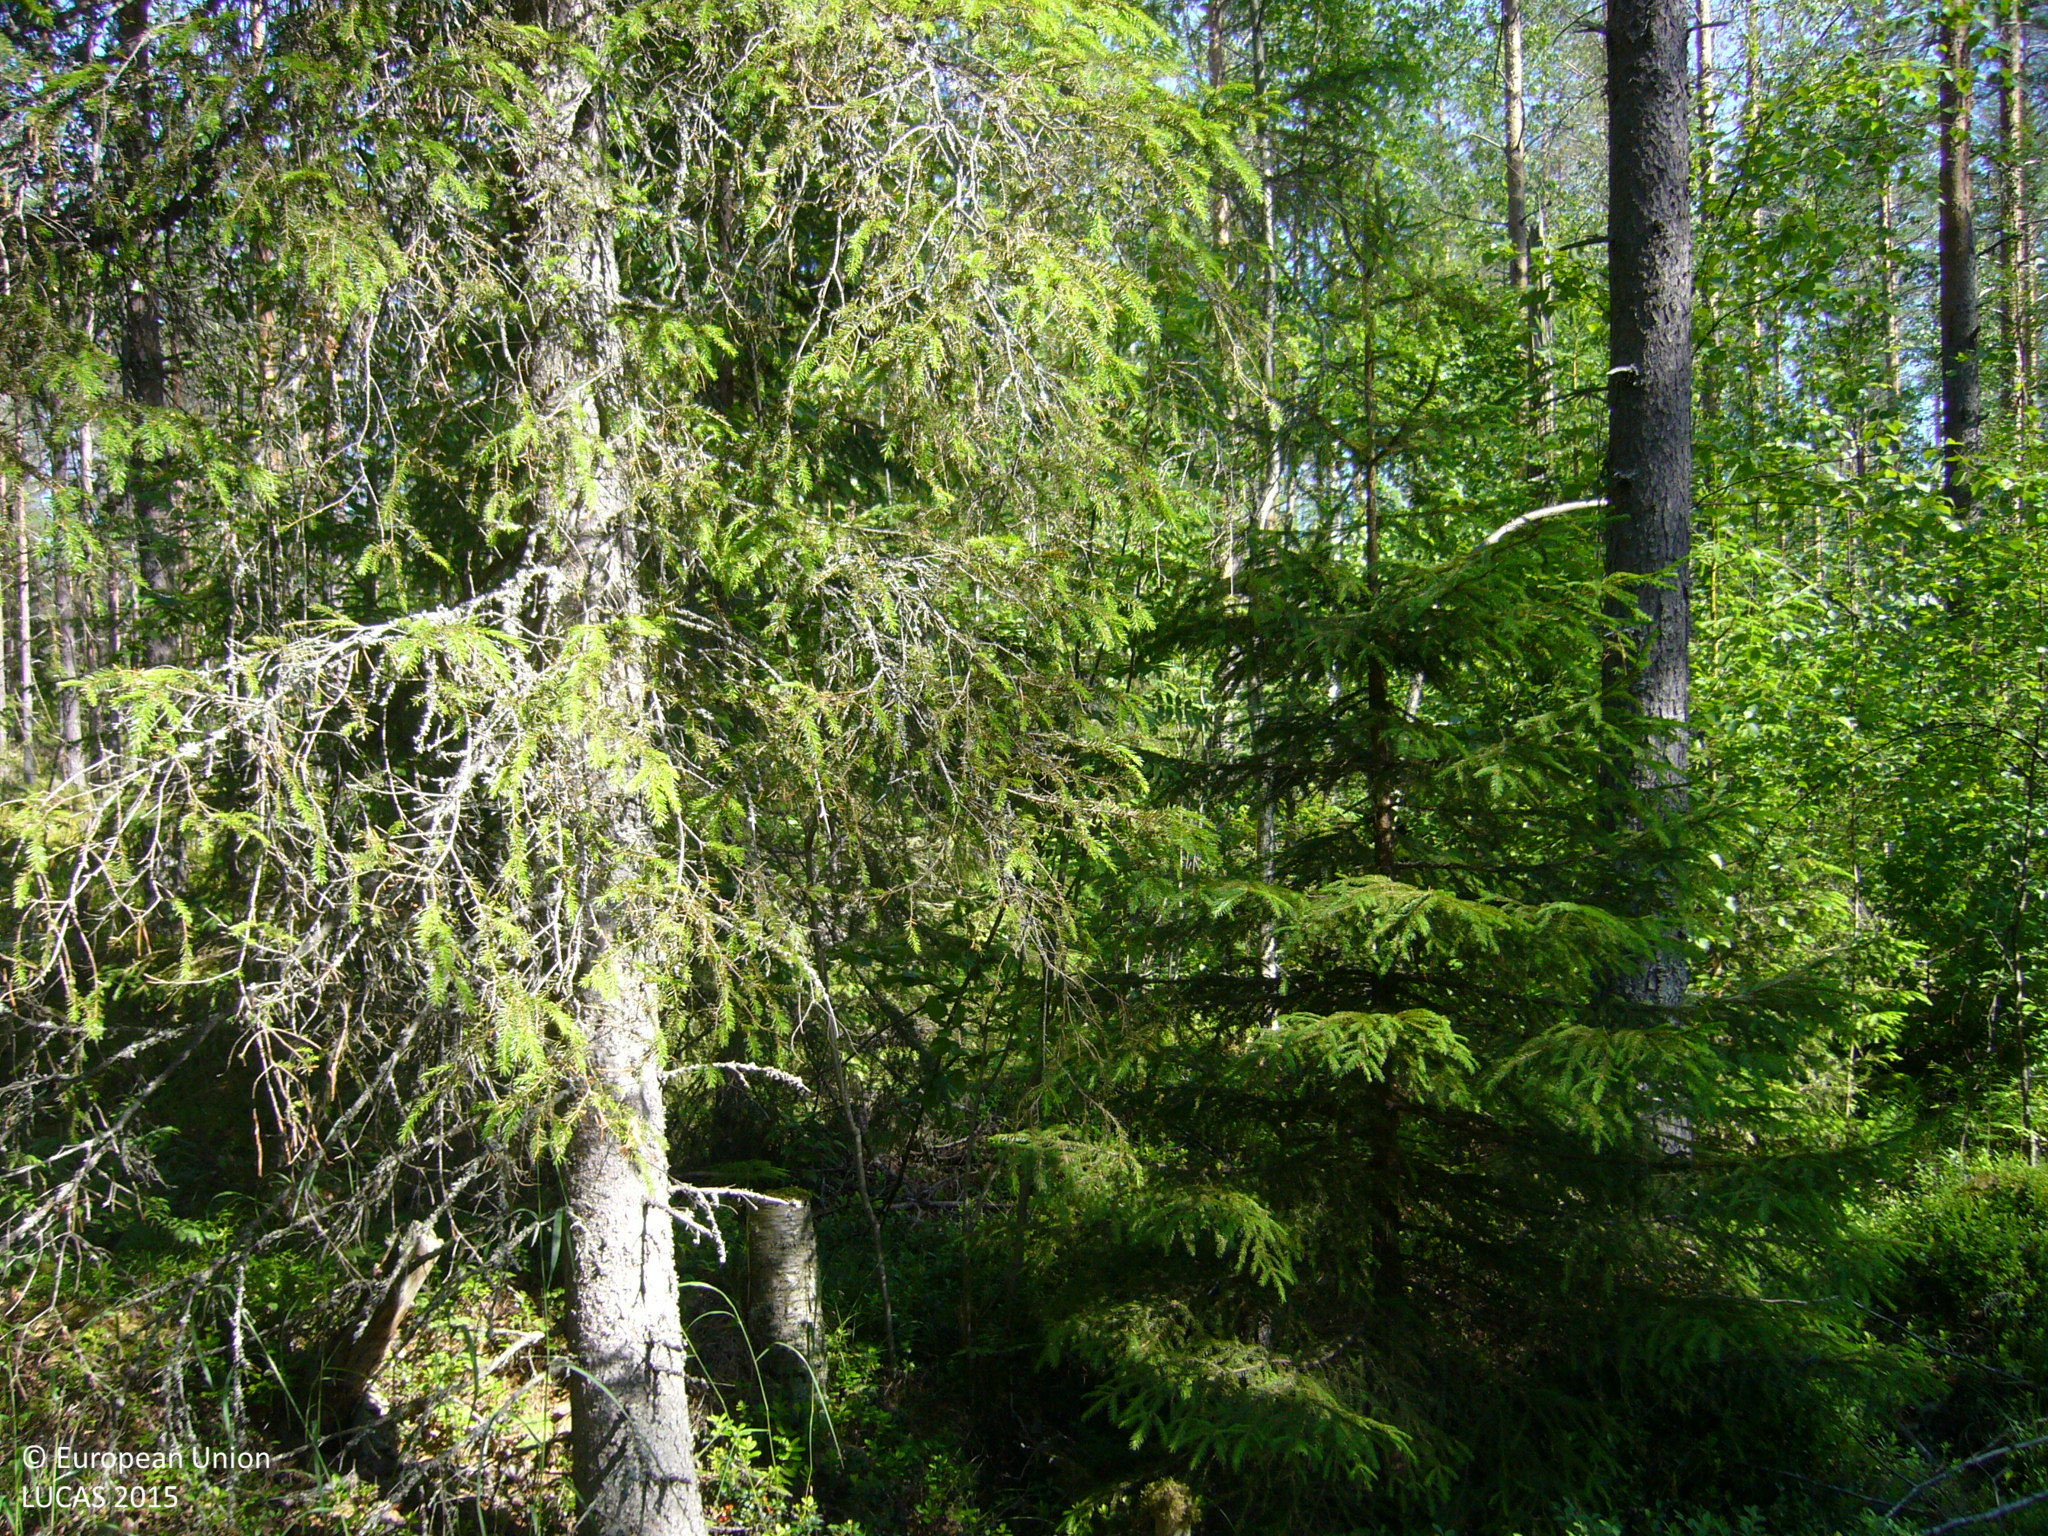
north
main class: Woodland
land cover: Pine dominated coniferous woodland
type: boreal forest
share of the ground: 50 - 75 %
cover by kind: coniferous forest trees 60 %, shrubs 30 %, broadleaved forest trees 10 %
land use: Forestry
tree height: > 5 m
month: July
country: FI
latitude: 63.3545
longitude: 25.8404
